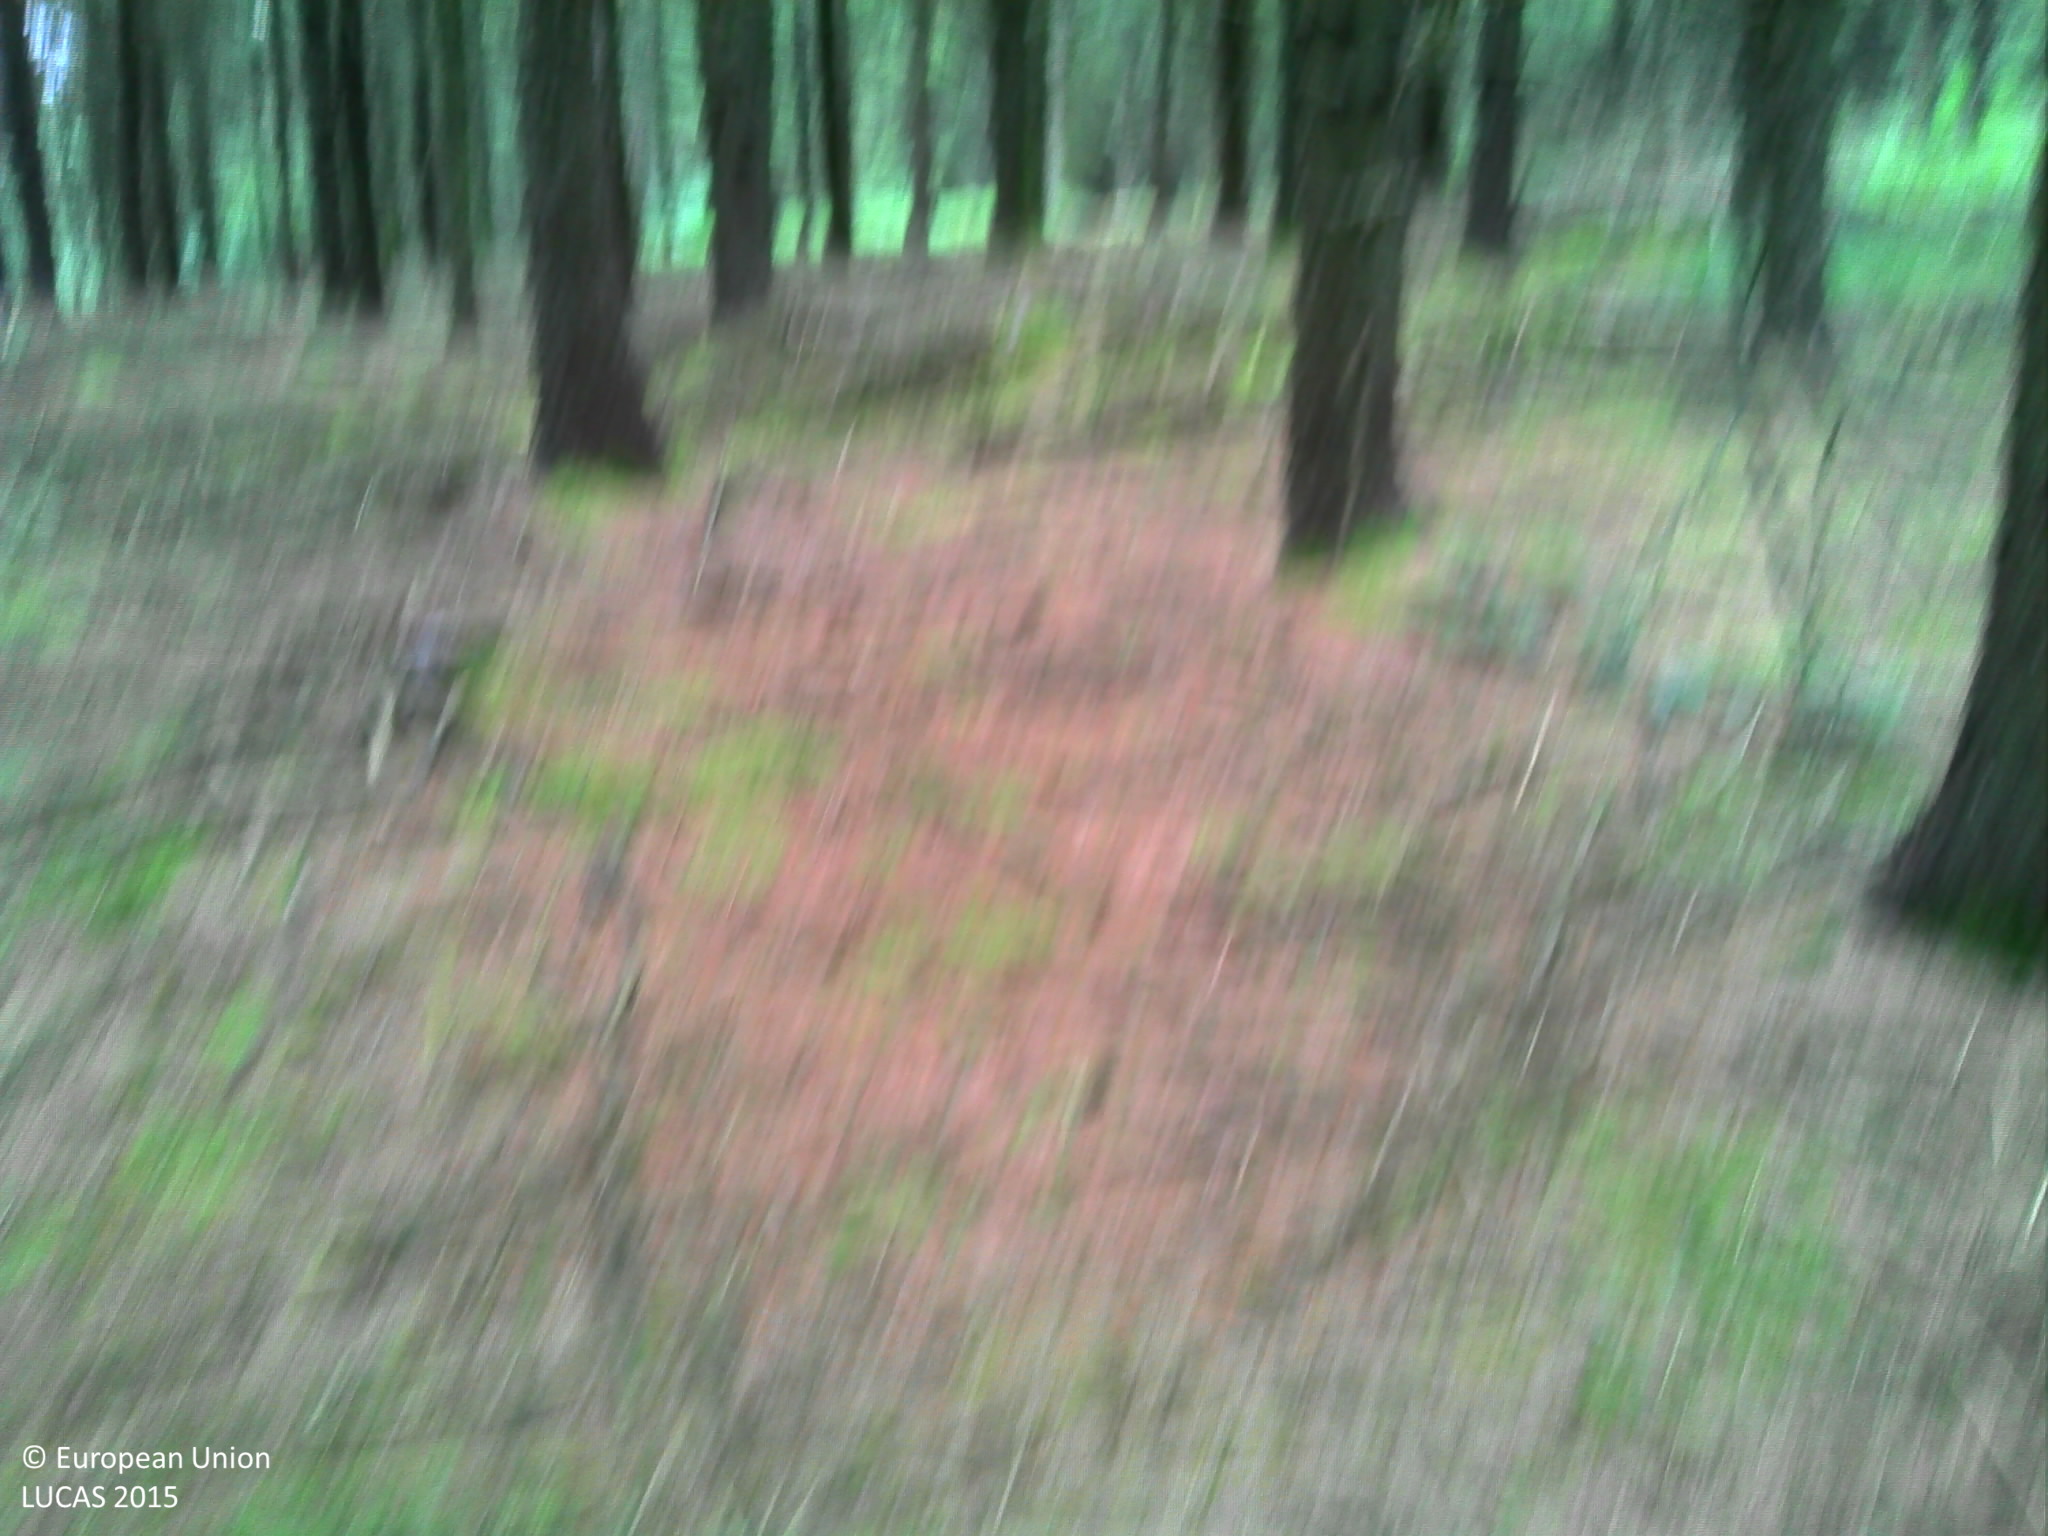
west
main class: Woodland
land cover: Spruce dominated coniferous woodland
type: exotic forest
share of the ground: > 75 %
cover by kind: coniferous forest trees 70 %, lichens and mosses 15 %, shrubs 5 %, herbaceous plants 5 %, consolidated bare surface 5 %
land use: Forestry
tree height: > 5 m
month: July
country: FR
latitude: 48.1549
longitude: -3.6439
